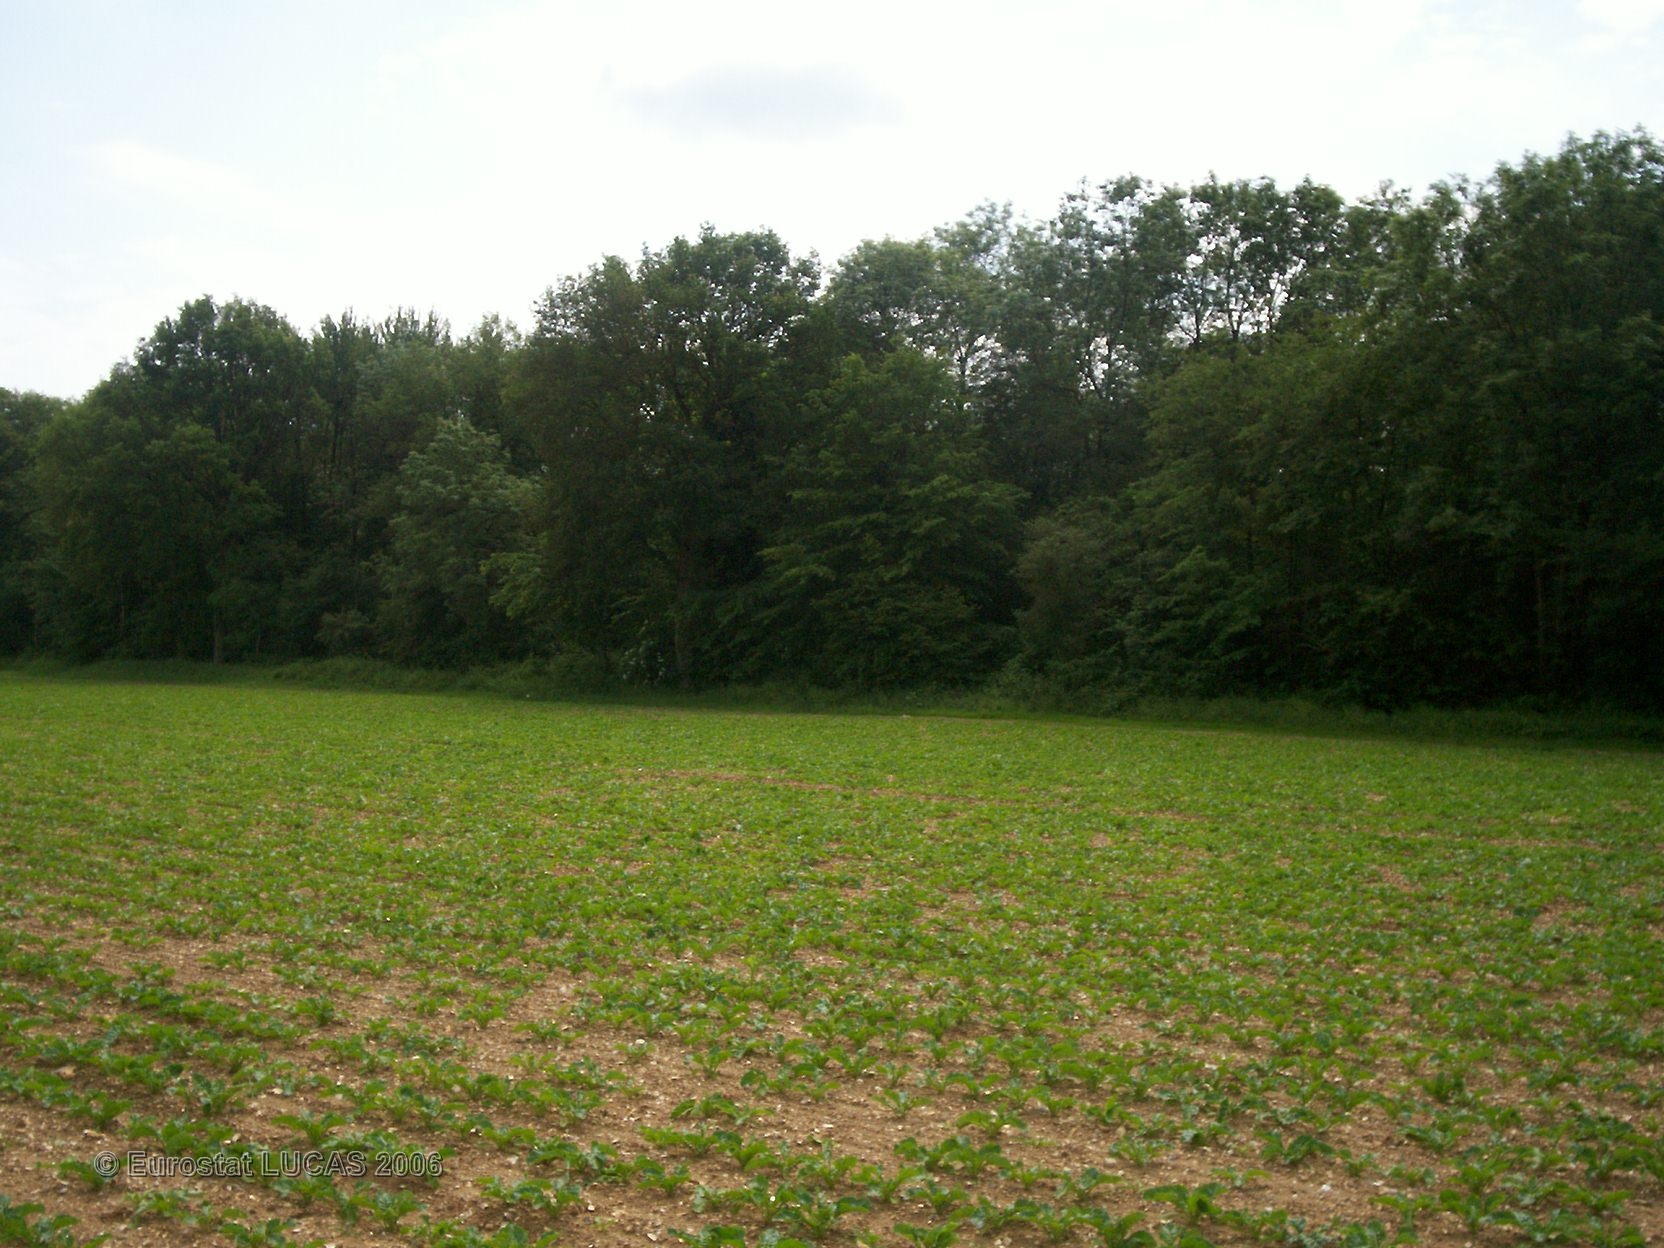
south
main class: Cropland
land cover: Sugar beet
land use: Agriculture (excluding fallow land and kitchen gardens)
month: June
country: FR
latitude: 49.7283
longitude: 2.6220
